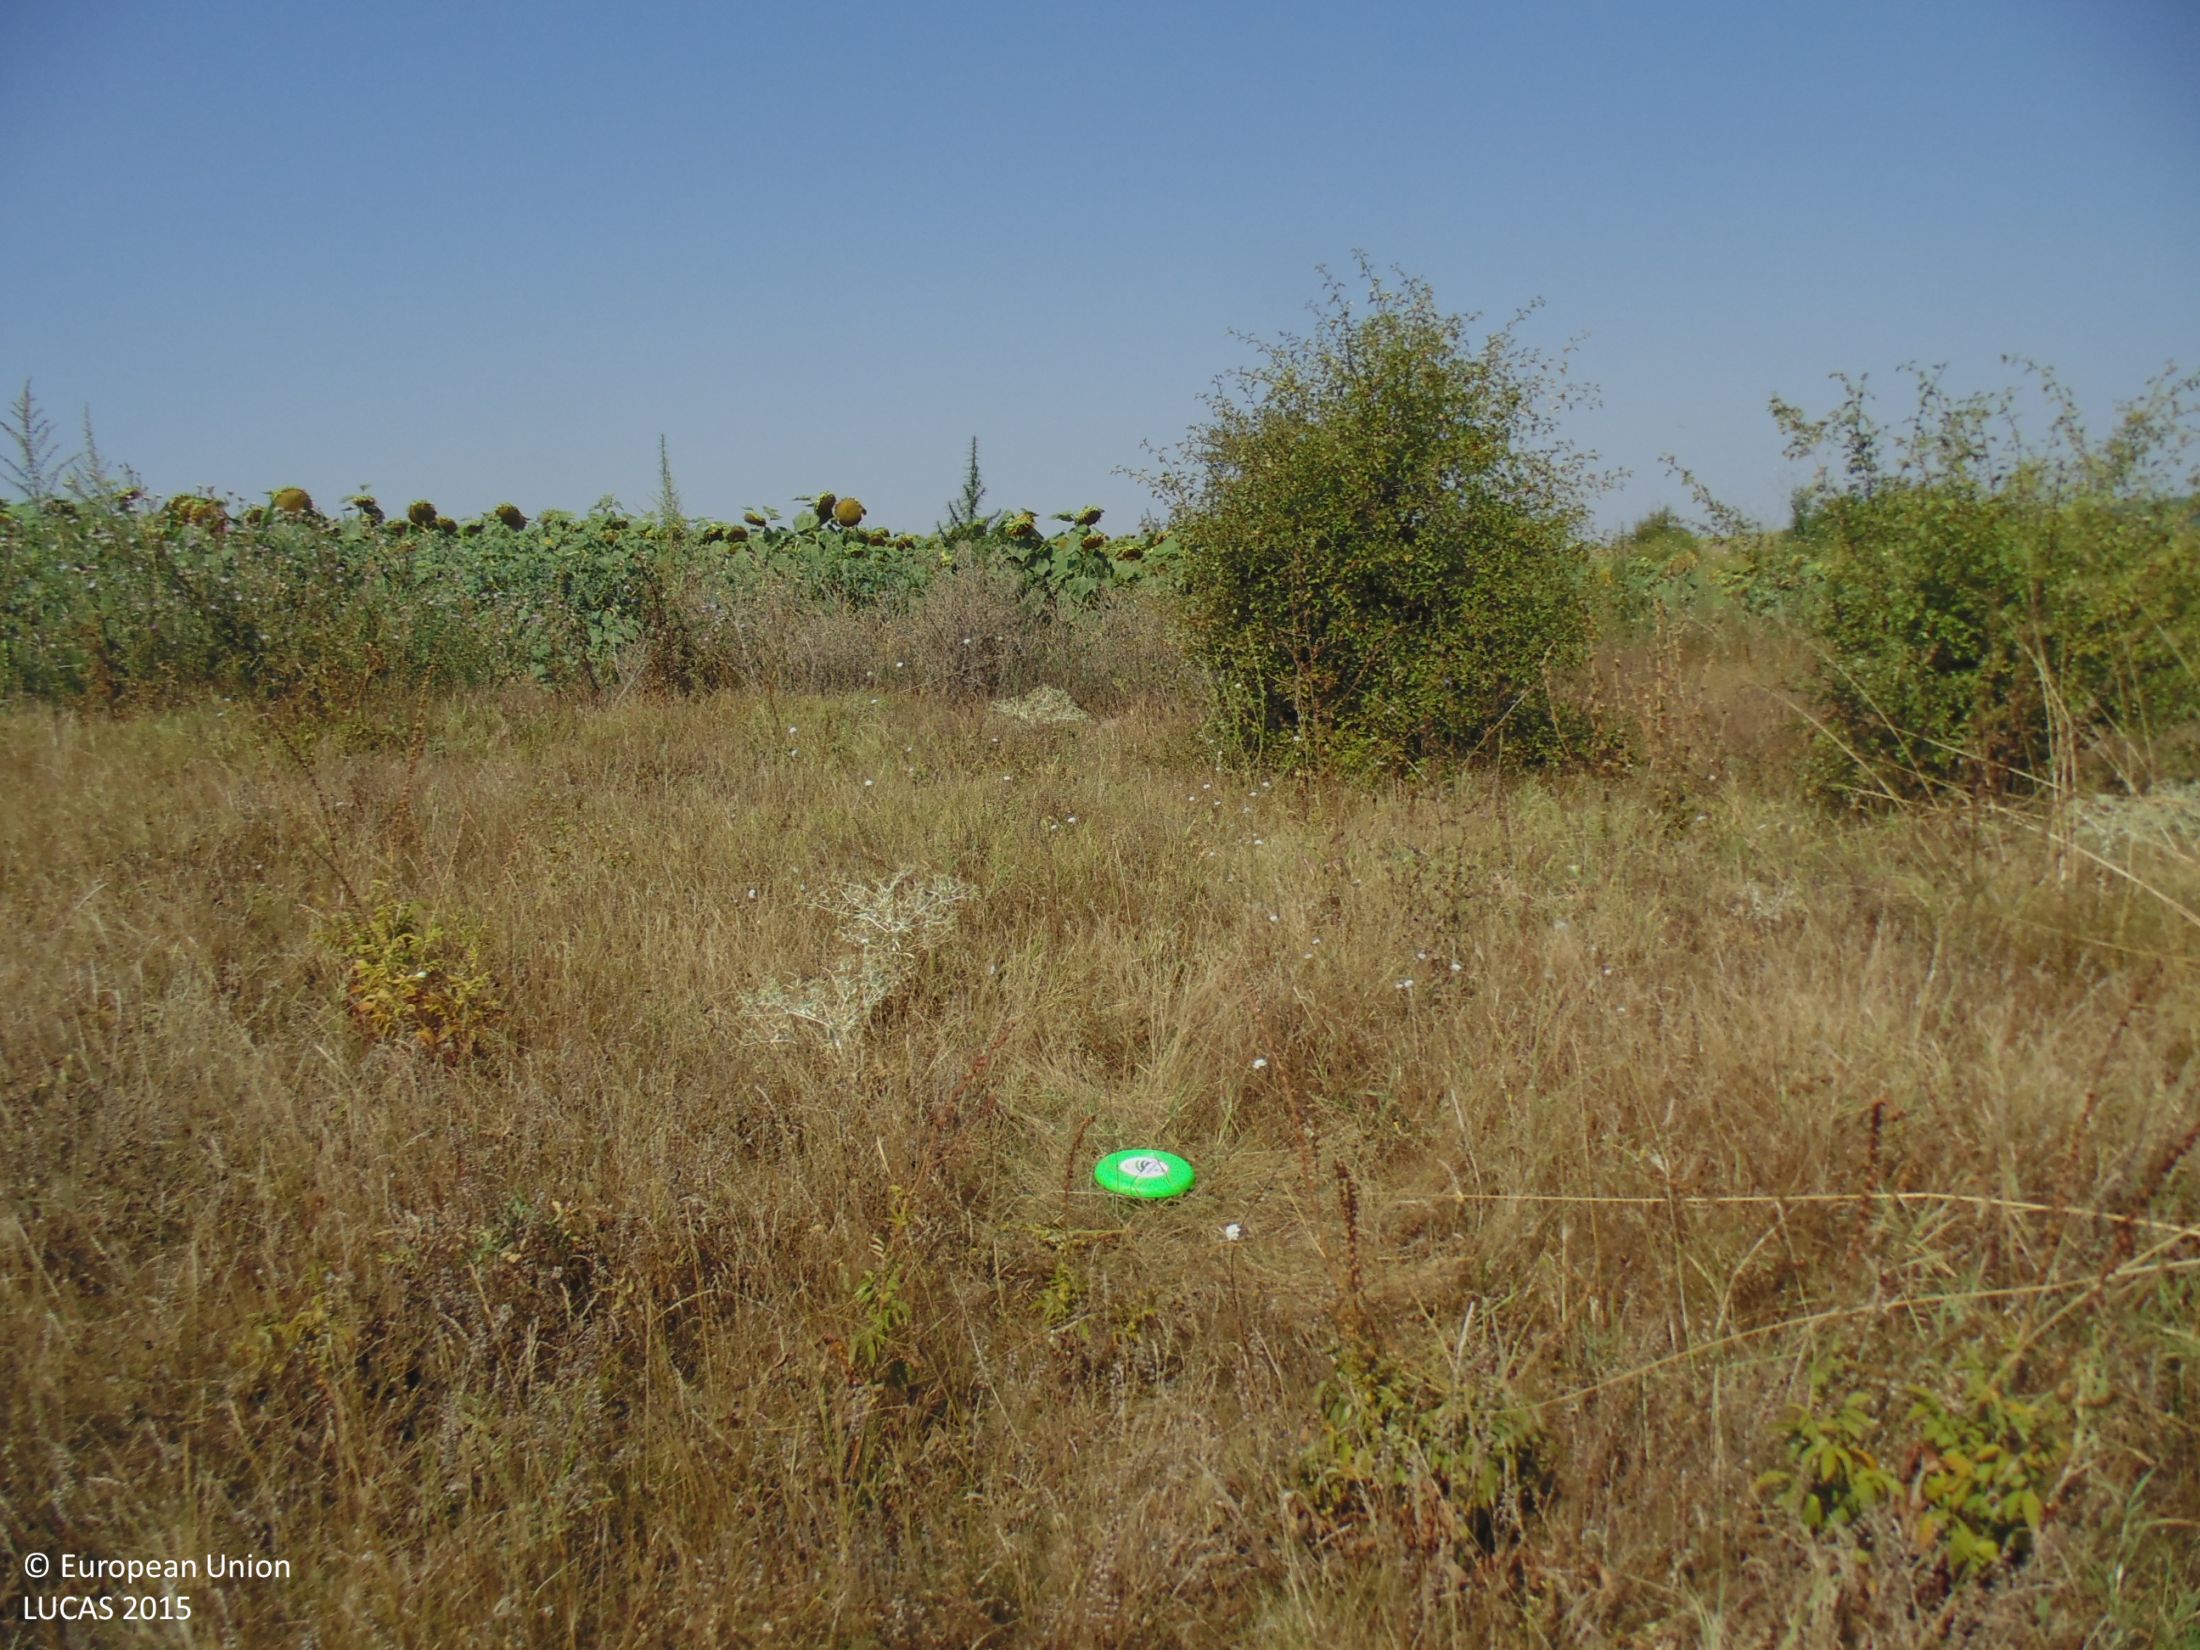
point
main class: Grassland
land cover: Grassland with sparse tree/shrub cover
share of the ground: > 75 %
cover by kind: herbaceous plants 90 %, broadleaved forest trees 5 %, shrubs 5 %
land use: Agriculture (excluding fallow land and kitchen gardens)
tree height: < 5 m
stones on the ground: < 10 %
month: August
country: BG
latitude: 43.9819
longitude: 27.5550
